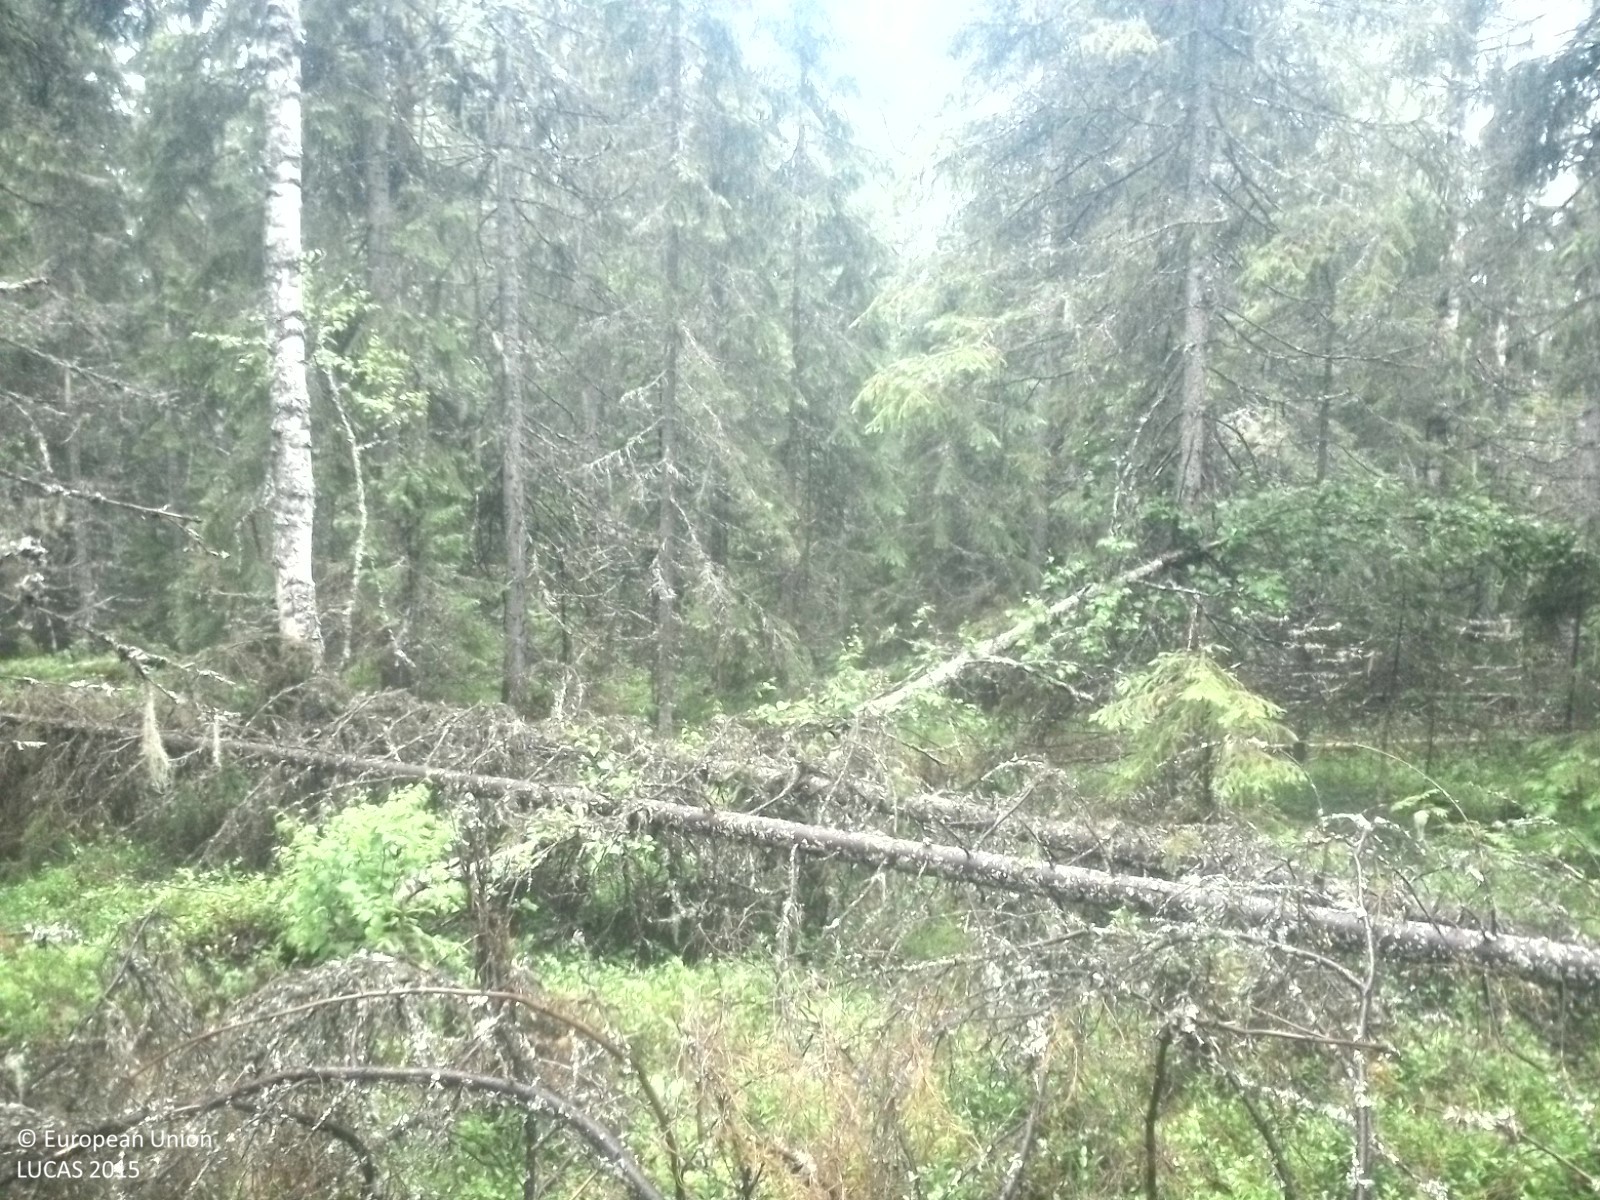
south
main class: Woodland
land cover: Spruce dominated mixed woodland
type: boreal forest
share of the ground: 50 - 75 %
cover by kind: coniferous forest trees 45 %, broadleaved forest trees 25 %, shrubs 15 %, lichens and mosses 15 %
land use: Forestry
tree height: > 5 m
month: July
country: SE
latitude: 62.4309
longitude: 17.0104
